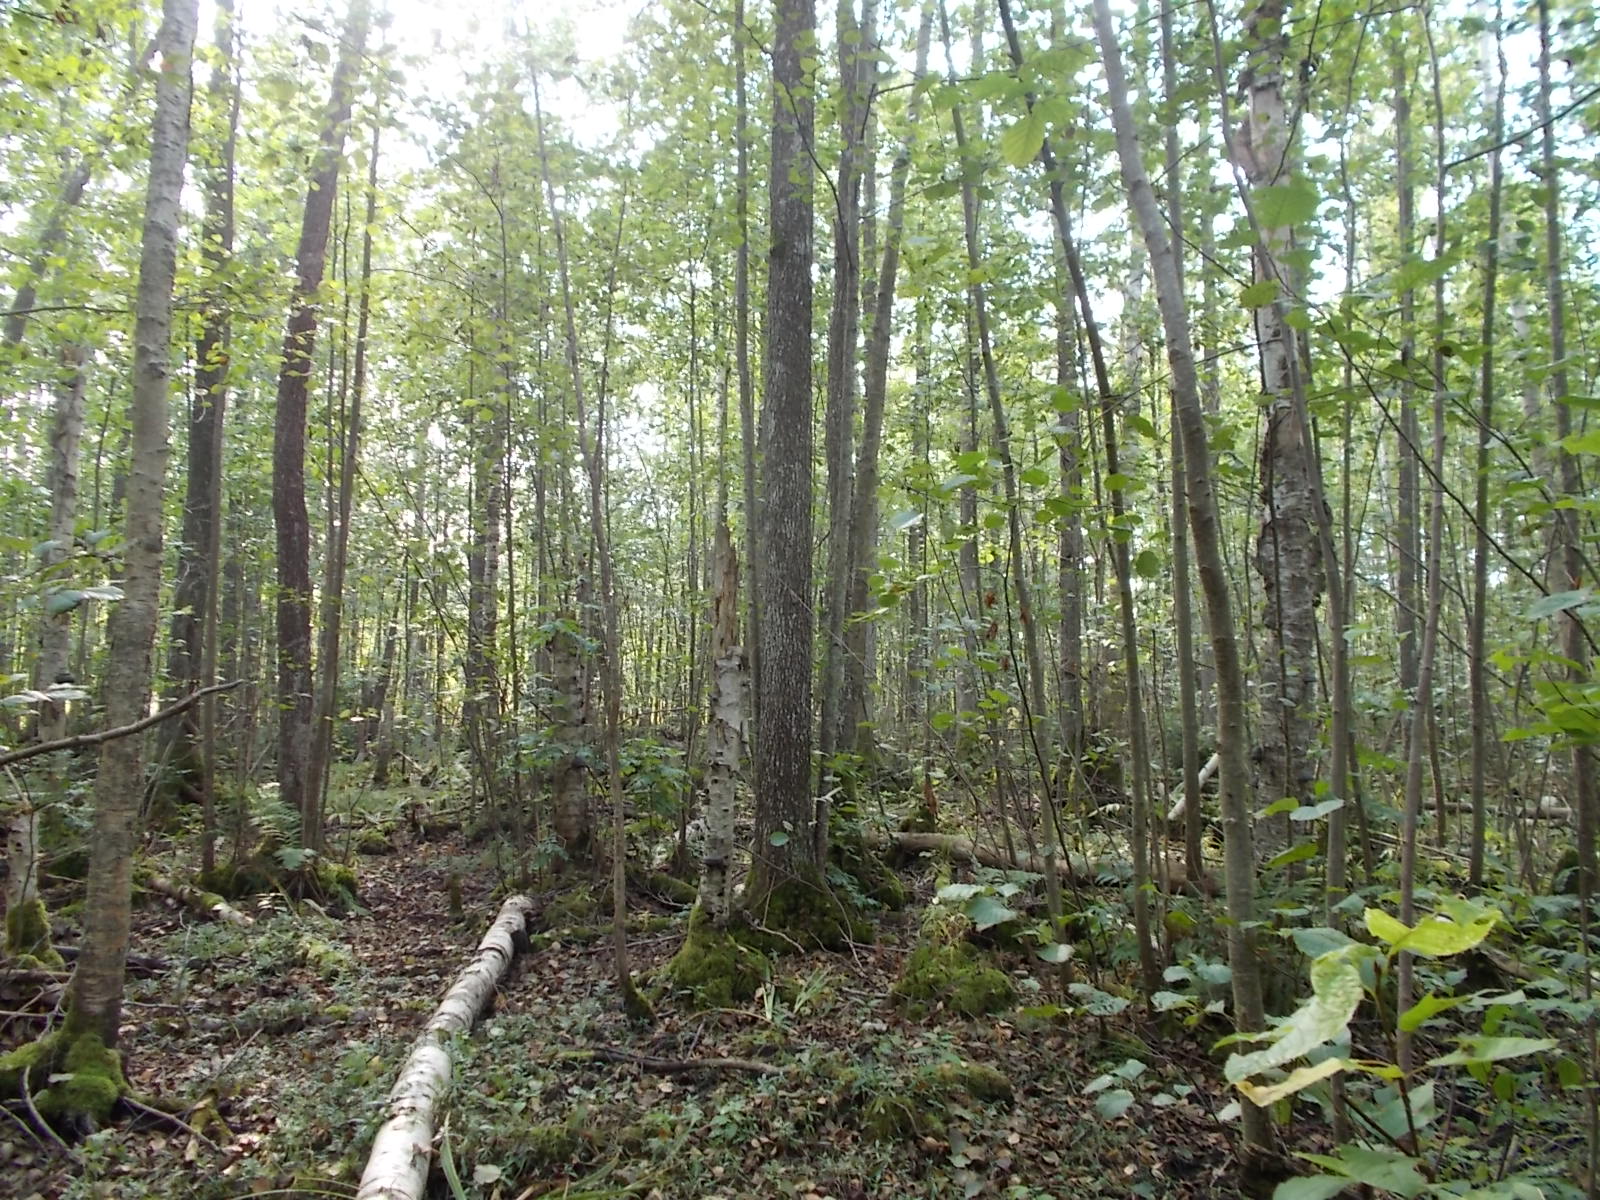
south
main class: Woodland
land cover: Broadleaved woodland
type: mire and swamp forests
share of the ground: > 75 %
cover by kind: broadleaved forest trees 90 %, herbaceous plants 10 %
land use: Forestry
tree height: > 5 m
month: September
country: LV
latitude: 56.9245
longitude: 23.5629
